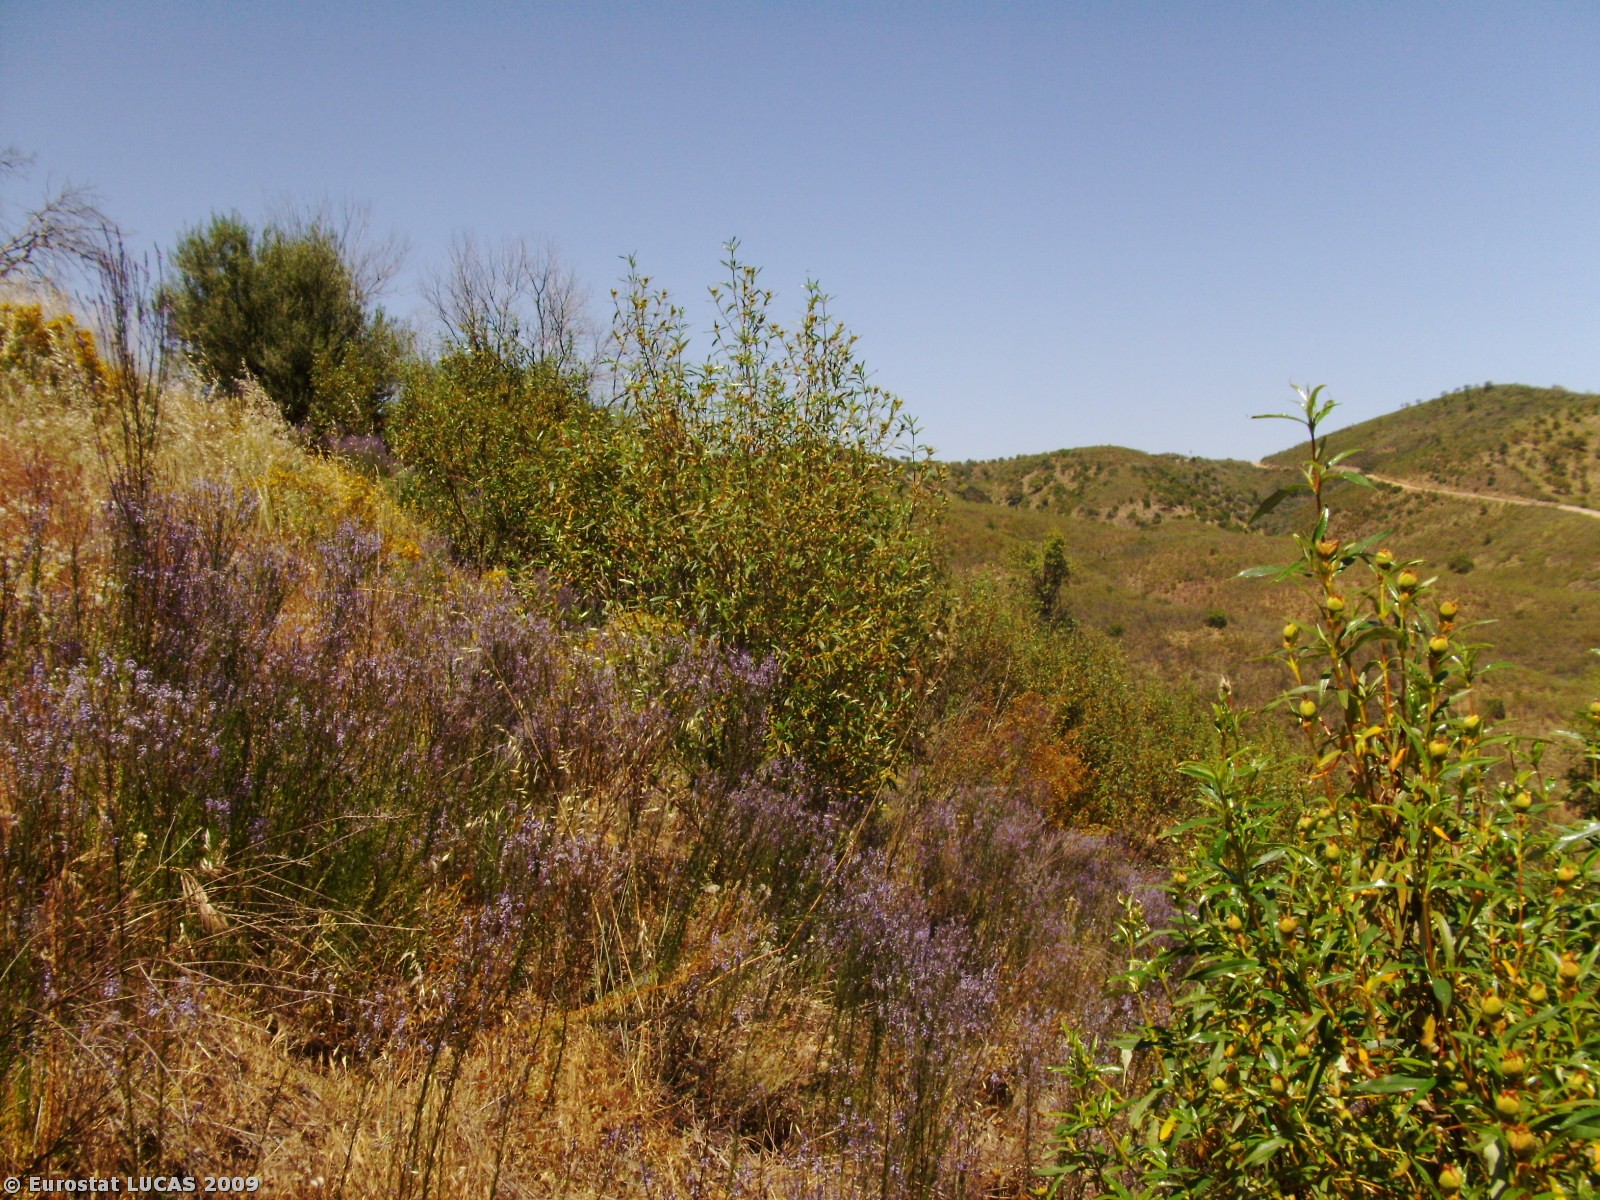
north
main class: Shrubland
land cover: Shrubland without tree cover
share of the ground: > 75 %
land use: Nature reserves
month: May
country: PT
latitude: 37.3355
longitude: -8.1585
